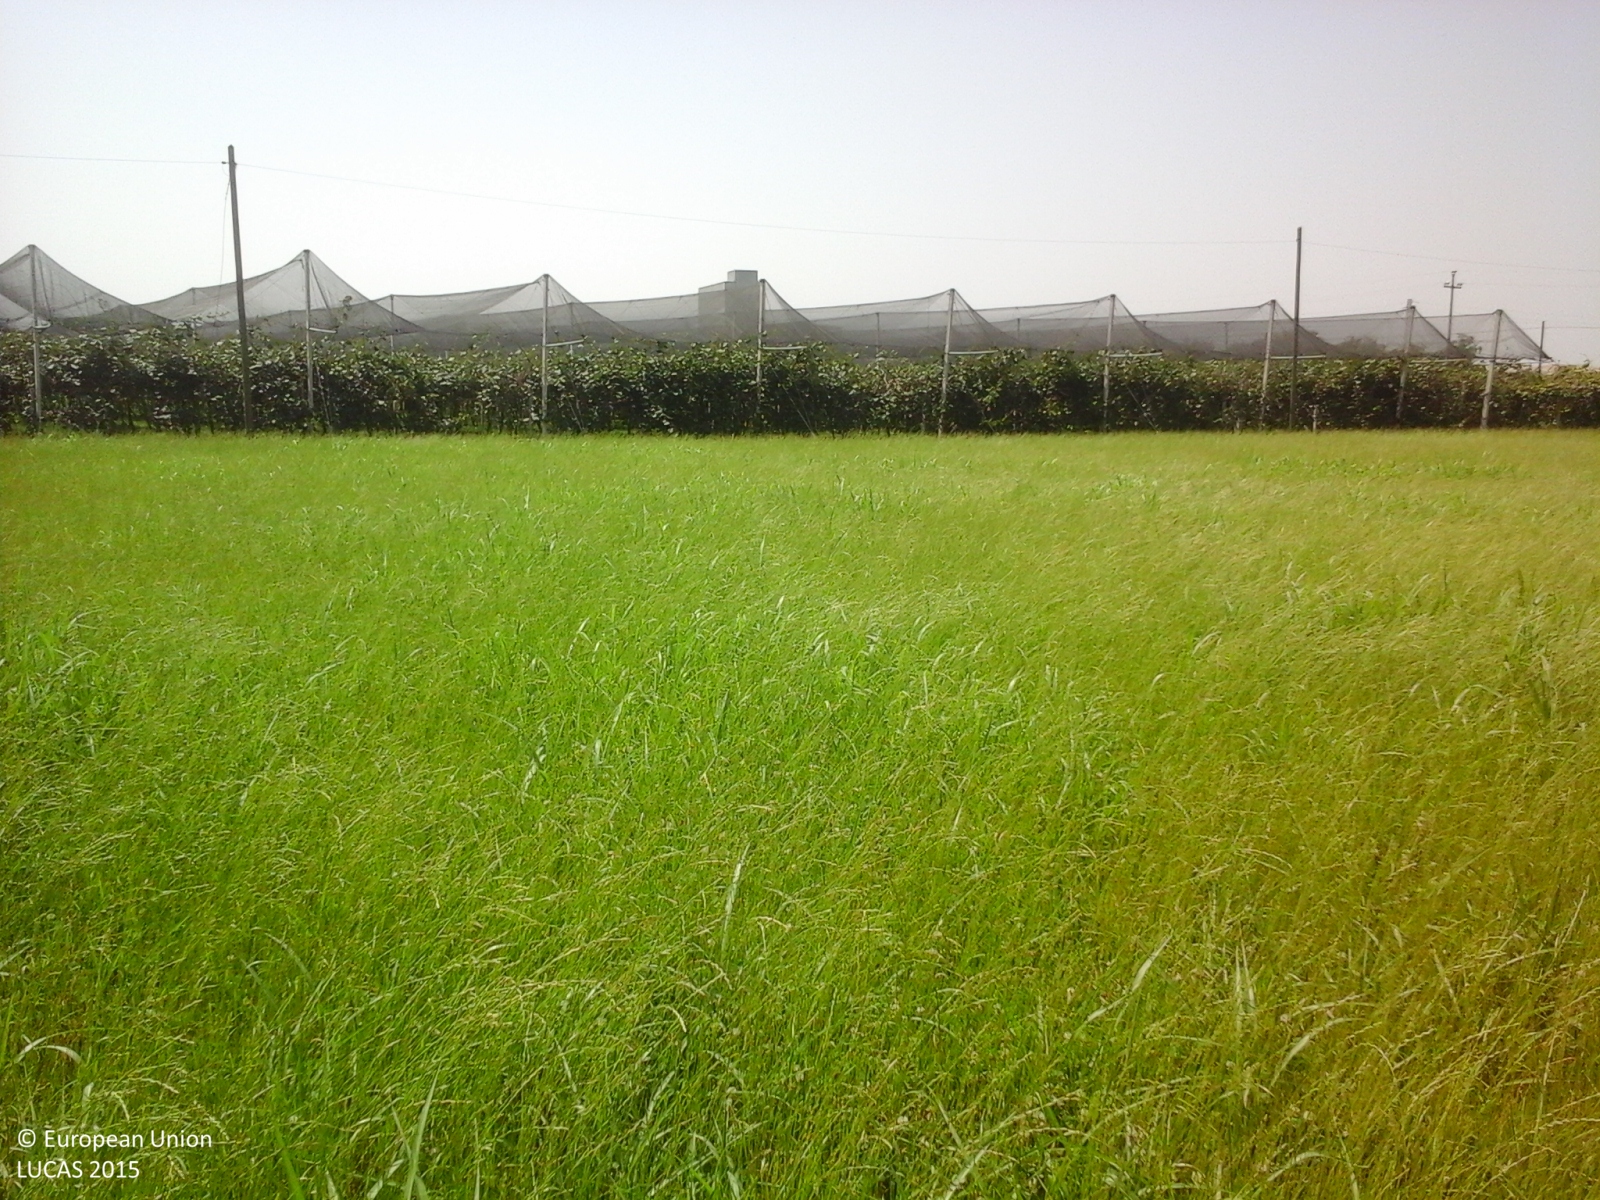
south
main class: Cropland
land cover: Temporary grasslands
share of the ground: > 75 %
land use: Agriculture (excluding fallow land and kitchen gardens)
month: July
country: IT
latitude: 45.3215
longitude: 10.7513
